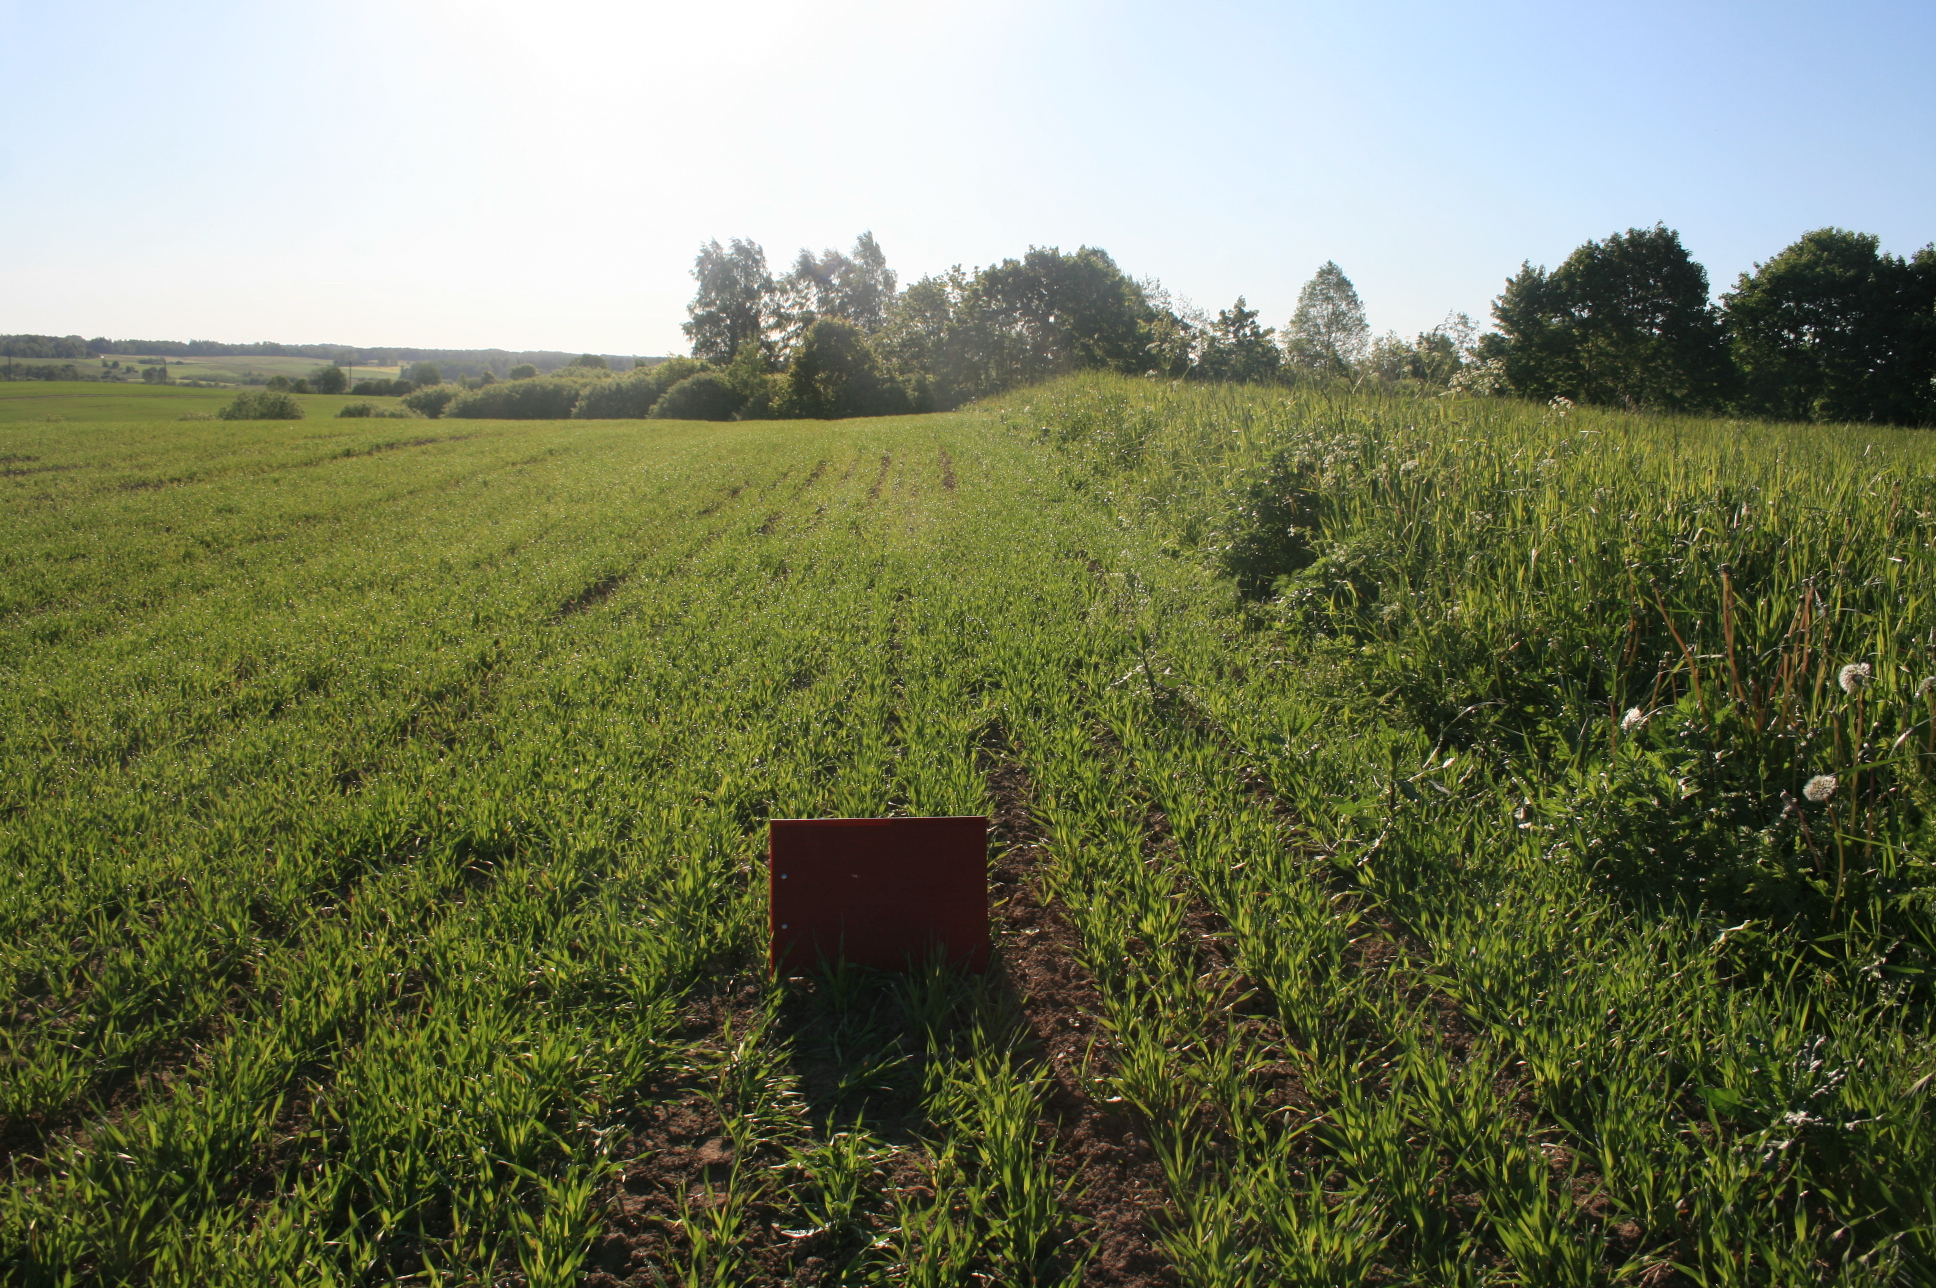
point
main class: Cropland
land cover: Barley
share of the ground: > 75 %
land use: Agriculture (excluding fallow land and kitchen gardens)
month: June
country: LT
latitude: 55.9131
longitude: 22.0028
